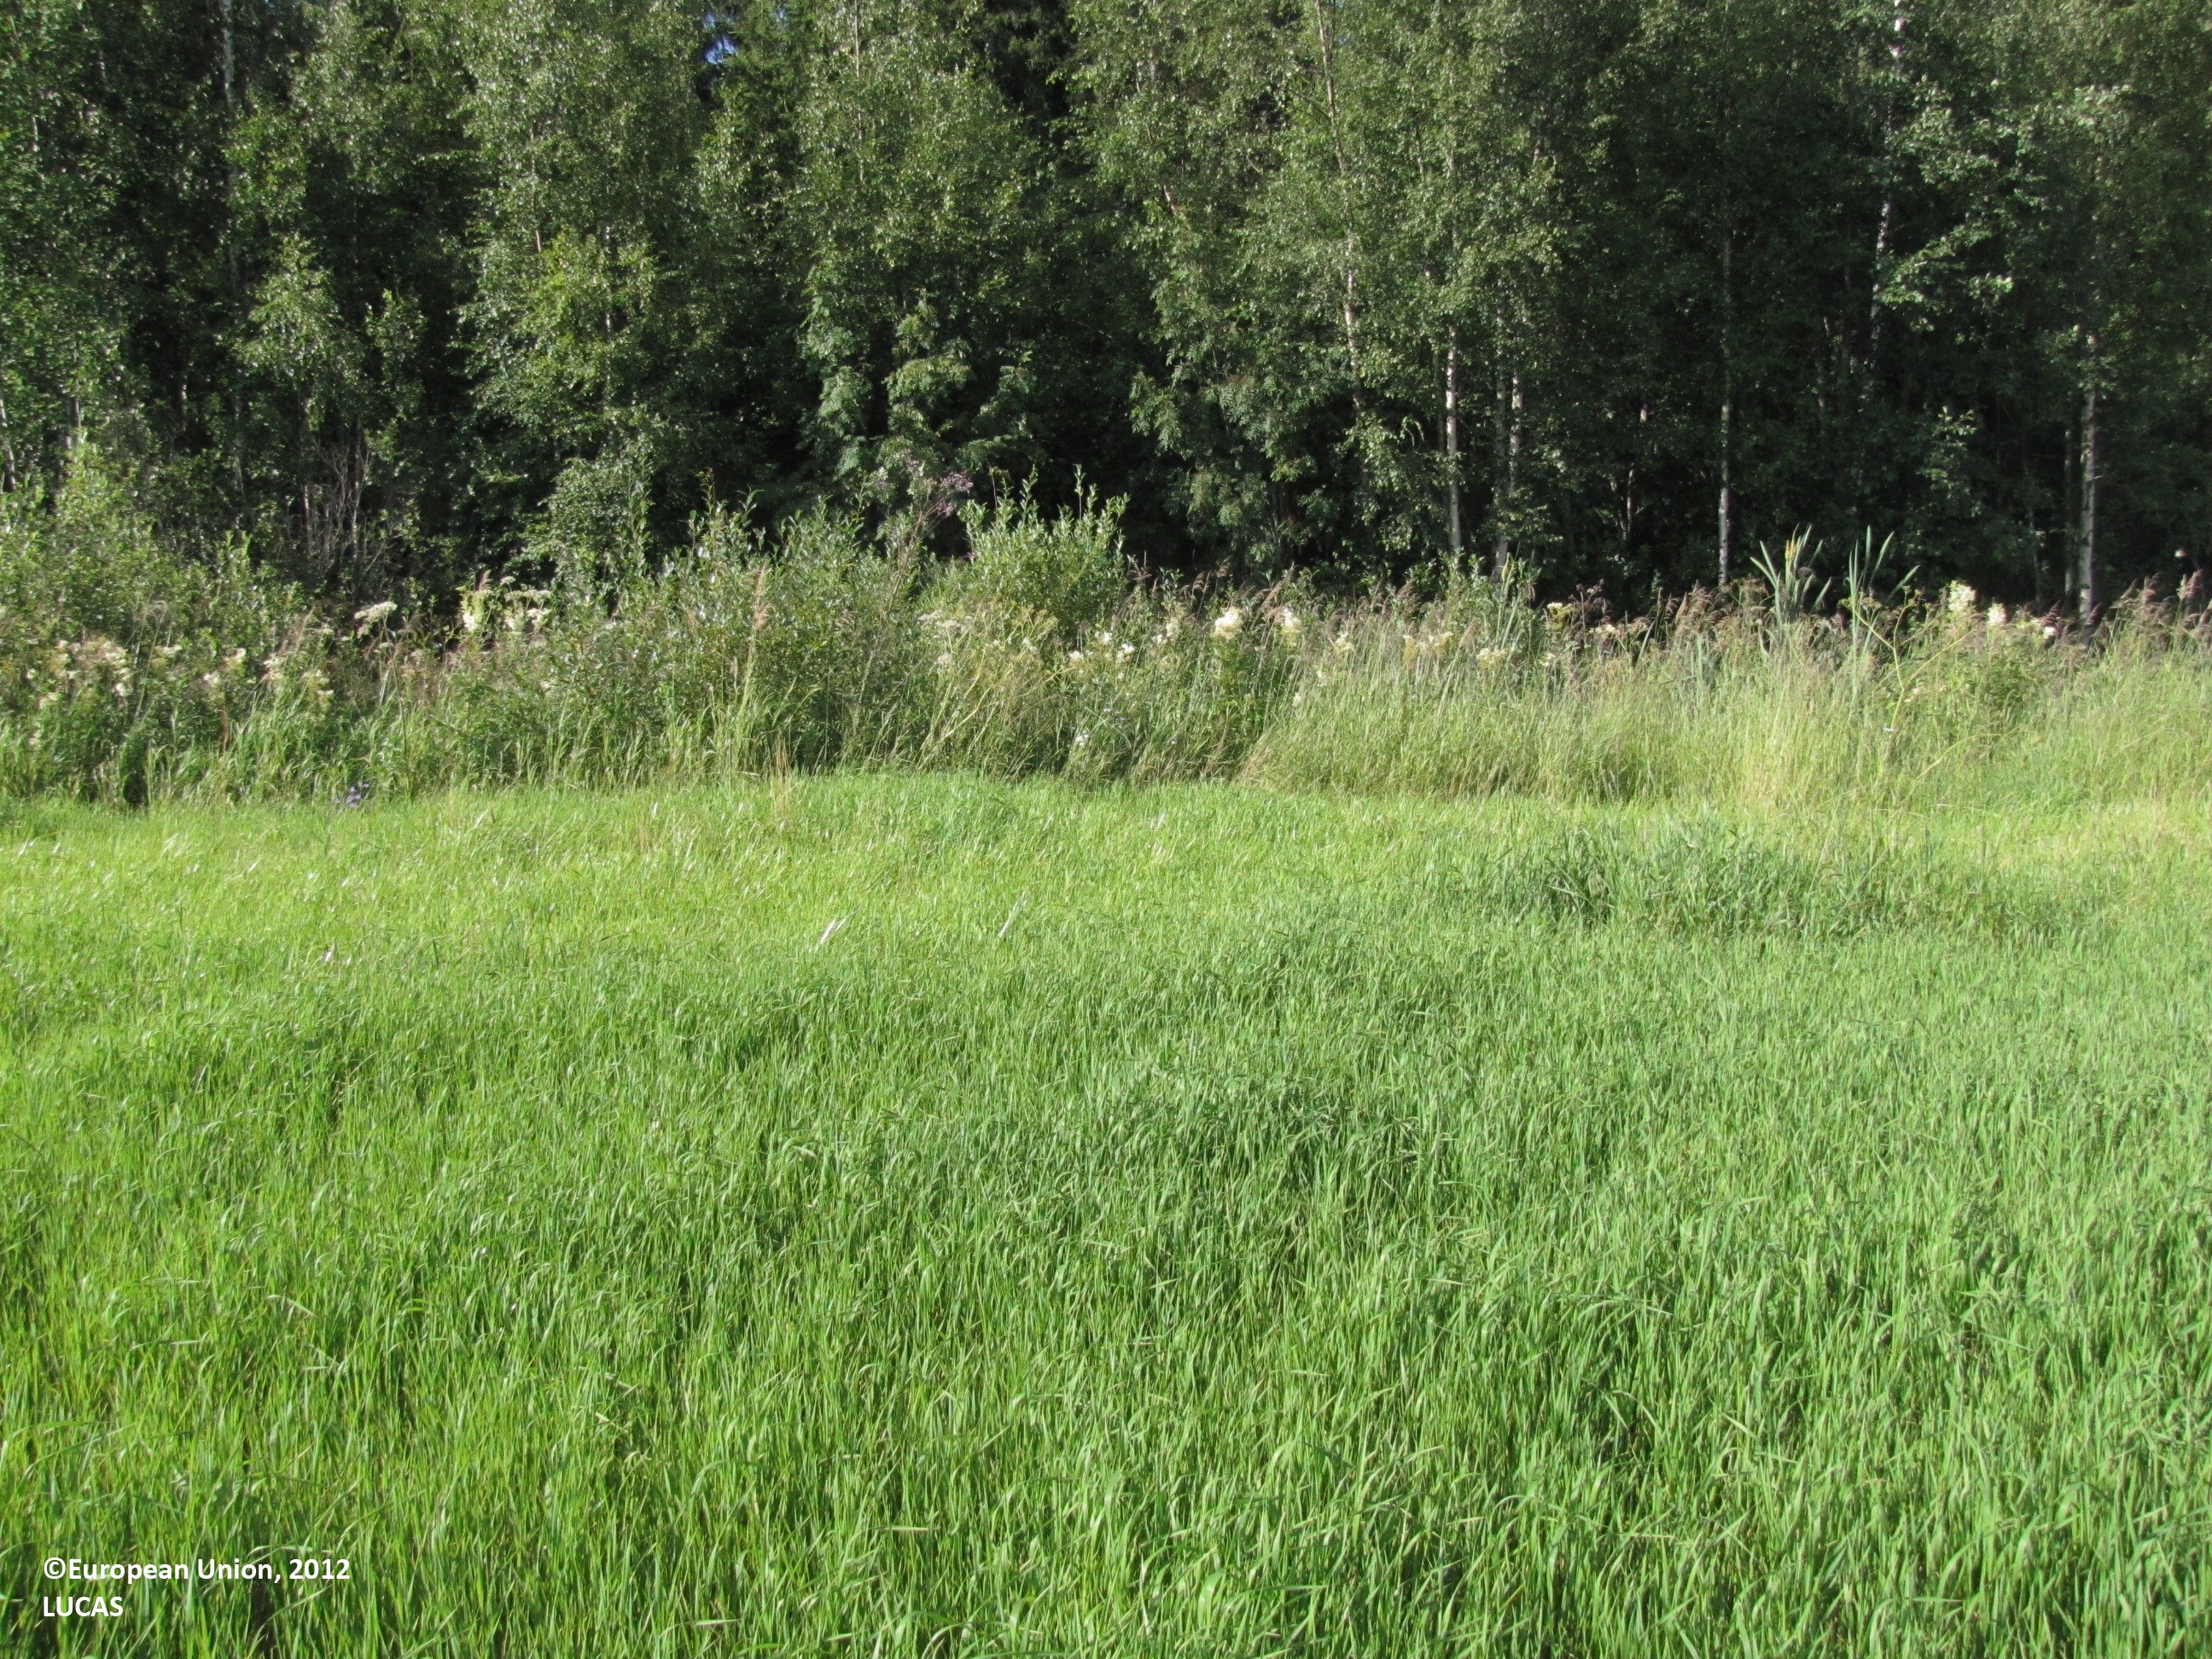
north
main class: Cropland
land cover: Temporary grasslands
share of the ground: > 75 %
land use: Agriculture (excluding fallow land and kitchen gardens)
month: July
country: FI
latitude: 62.1296
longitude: 23.0875
